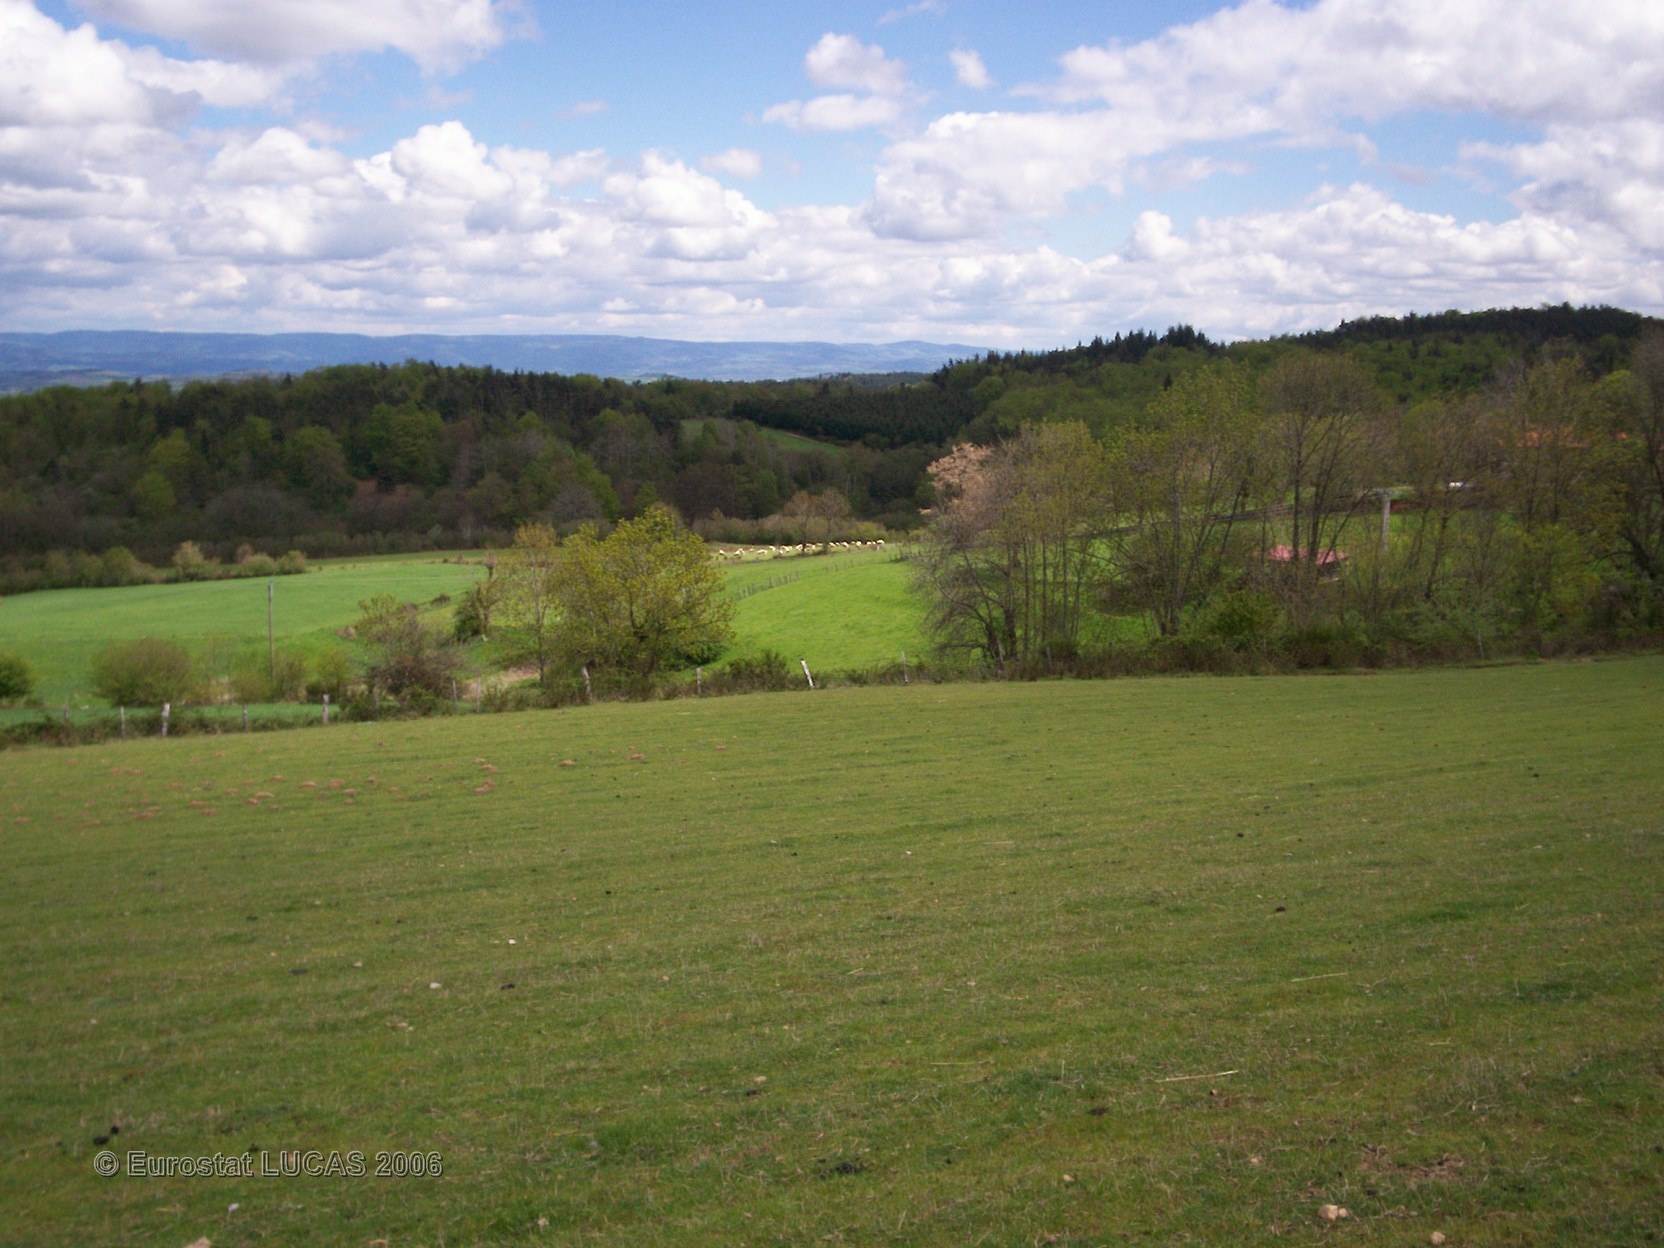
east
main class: Grassland
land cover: Grassland without tree/shrub cover
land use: Agriculture (excluding fallow land and kitchen gardens)
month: May
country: FR
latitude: 45.2023
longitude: 3.3187
